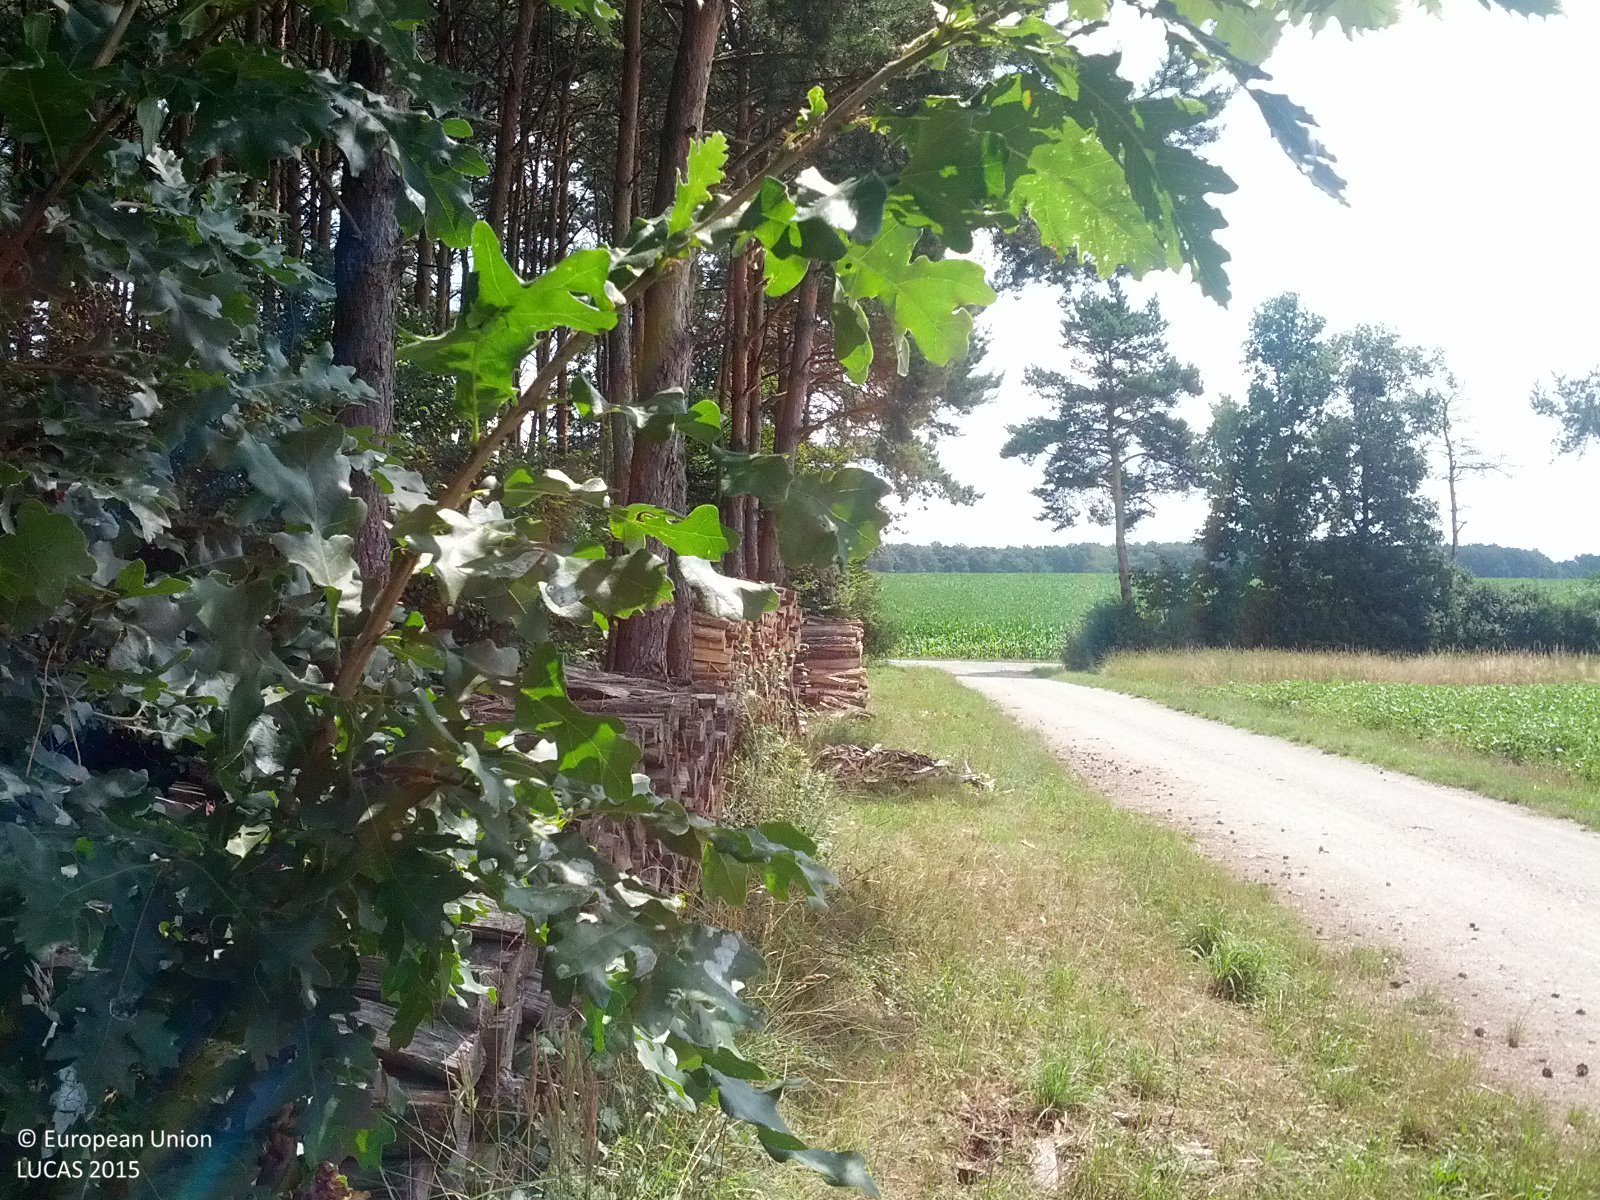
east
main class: Woodland
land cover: Pine dominated coniferous woodland
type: hemiboreal forest and nemoral coniferous forest and mixed broadleaved-coniferous forest
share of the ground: > 75 %
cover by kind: coniferous forest trees 80 %, shrubs 10 %, herbaceous plants 10 %
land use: Forestry
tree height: > 5 m
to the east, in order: Pine dominated coniferous woodland; Groves; Ditches and canals; Grass margins; Tracks; Grass margins; Maize
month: July
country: AT
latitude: 47.2457
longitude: 16.3575
